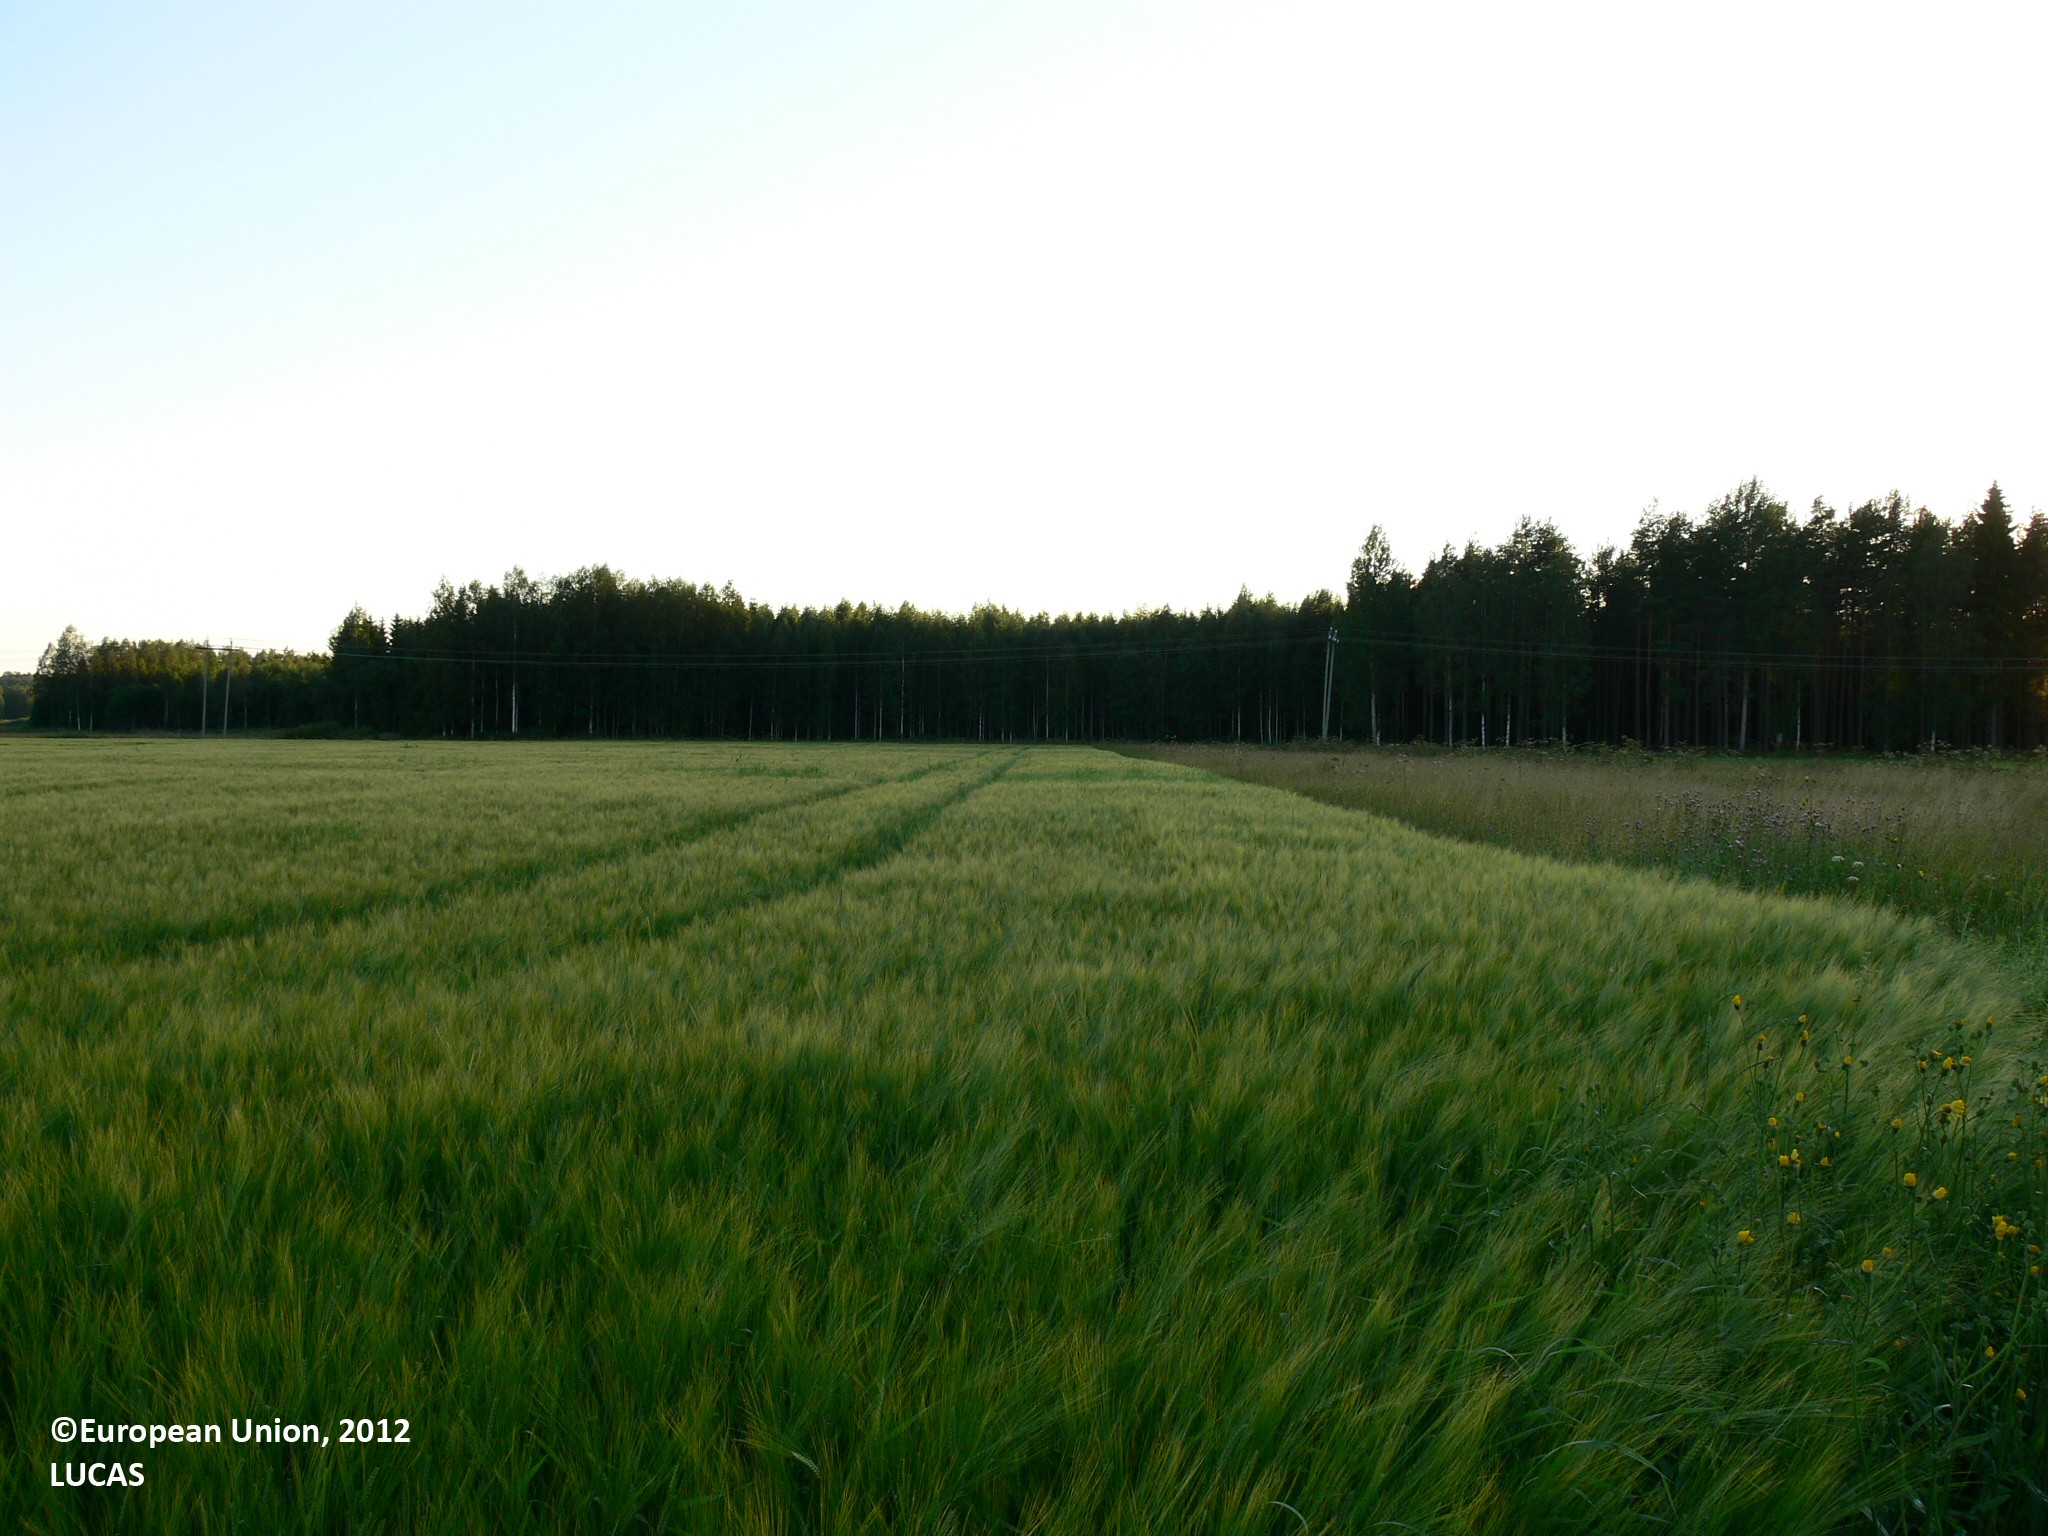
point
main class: Cropland
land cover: Barley
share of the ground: > 75 %
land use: Agriculture (excluding fallow land and kitchen gardens)
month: August
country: FI
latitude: 61.9091
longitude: 29.2544
